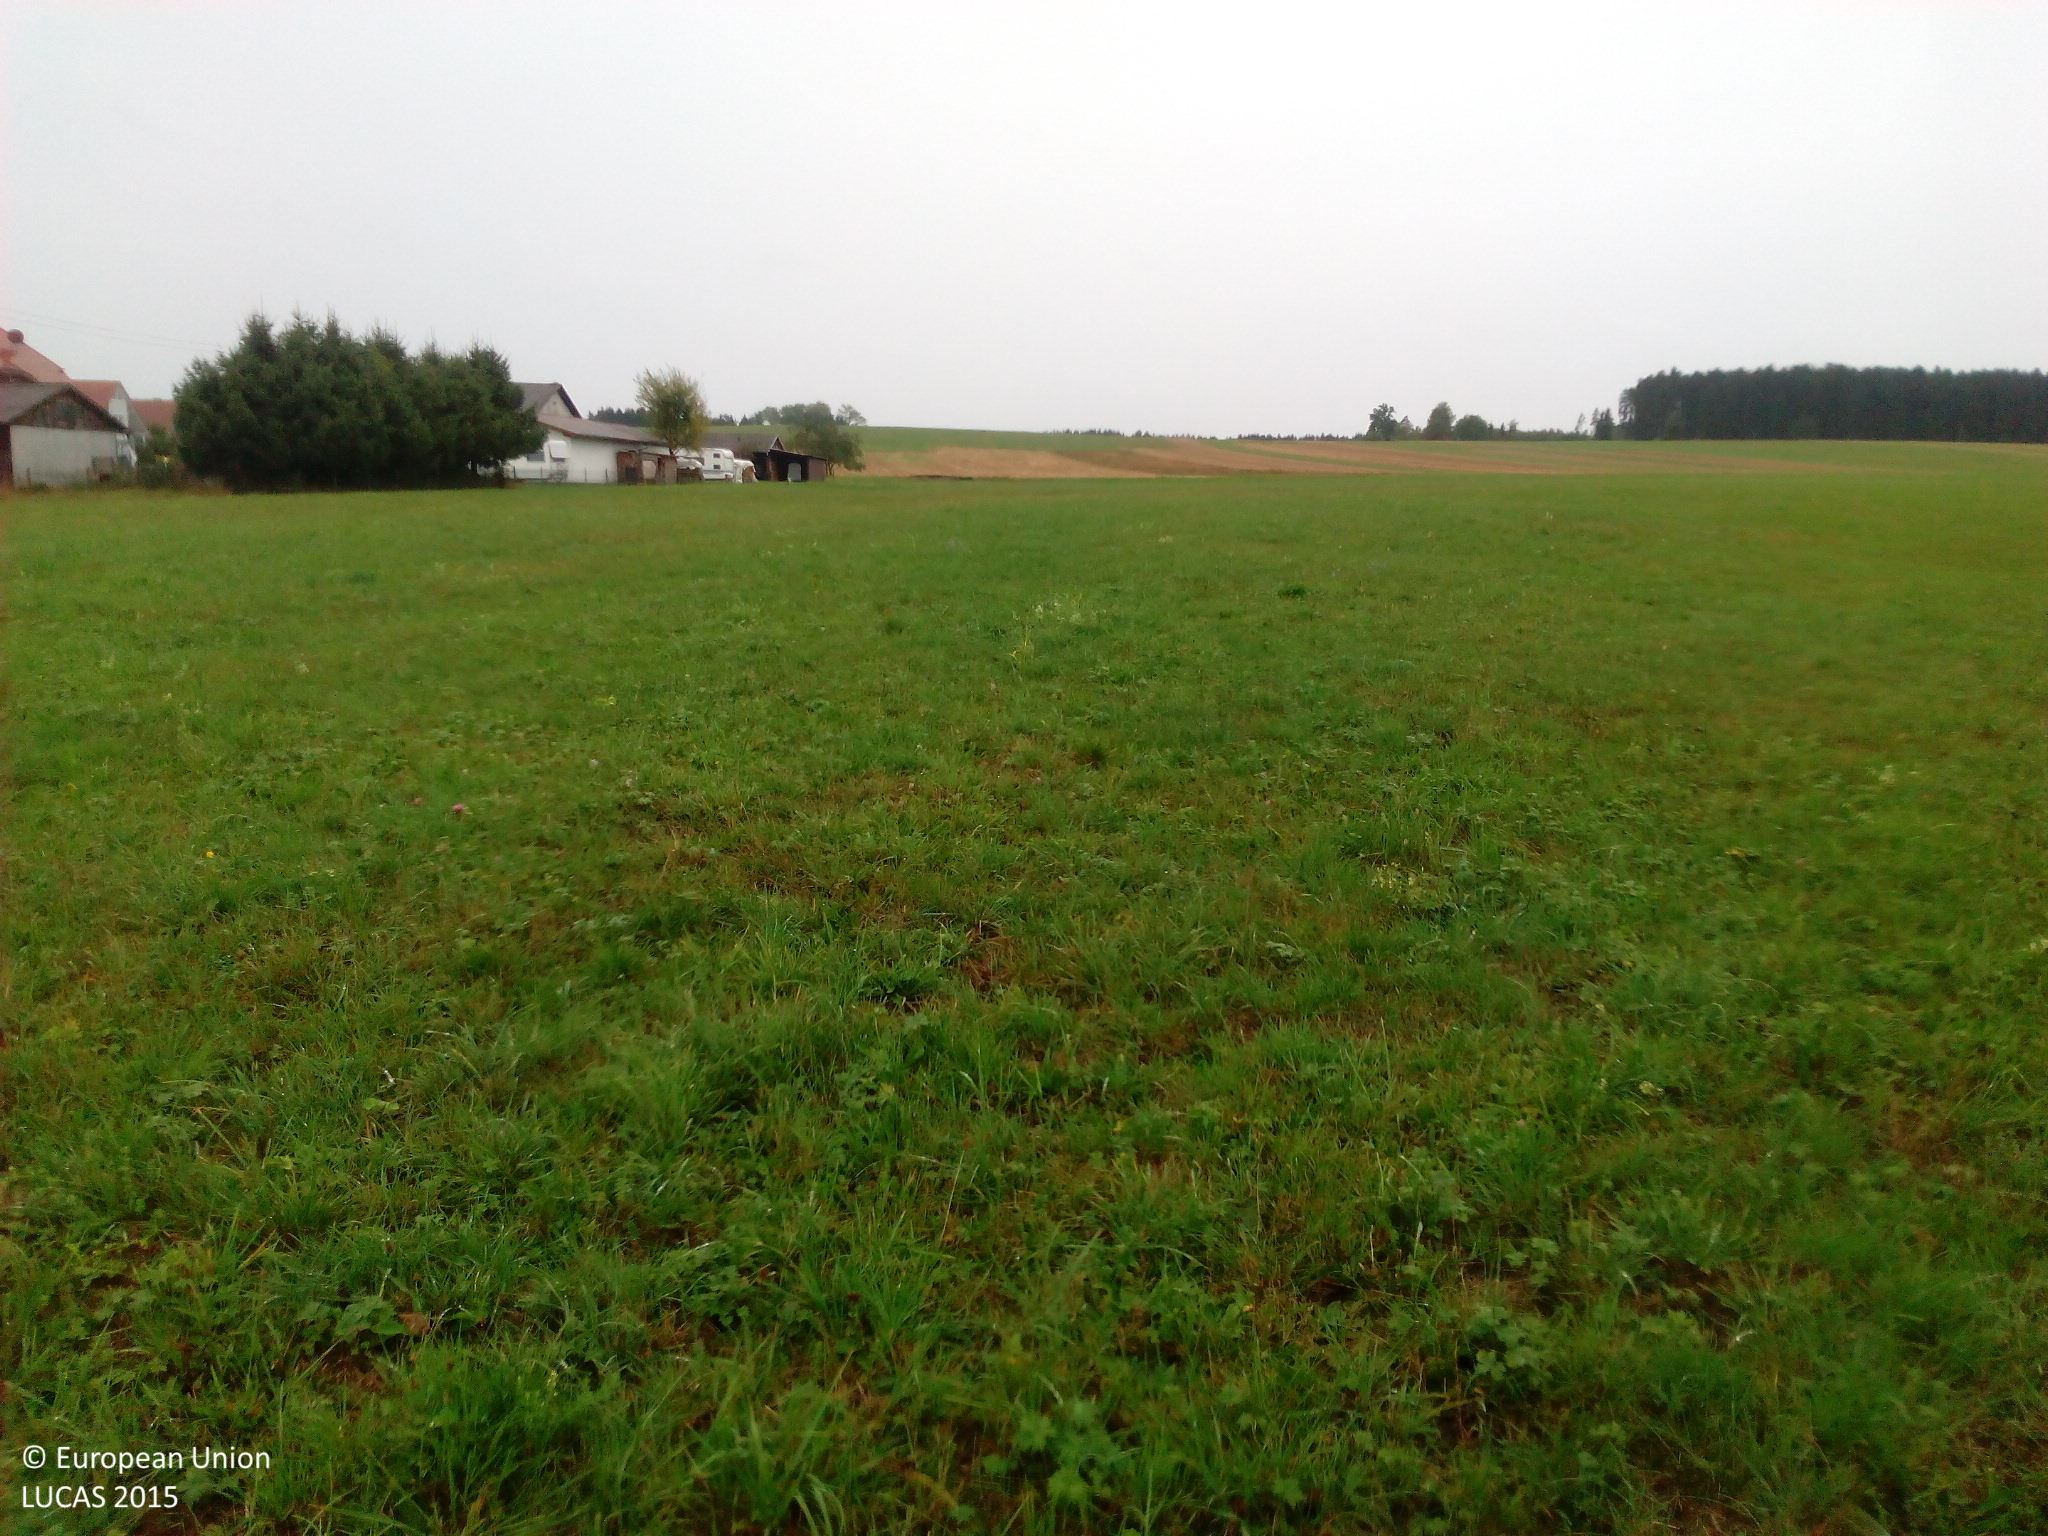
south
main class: Grassland
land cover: Grassland without tree/shrub cover
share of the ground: > 75 %
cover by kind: herbaceous plants 95 %, unconsolidated bare surface 5 %
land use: Agriculture (excluding fallow land and kitchen gardens)
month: September
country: DE
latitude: 48.1439
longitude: 8.6971
